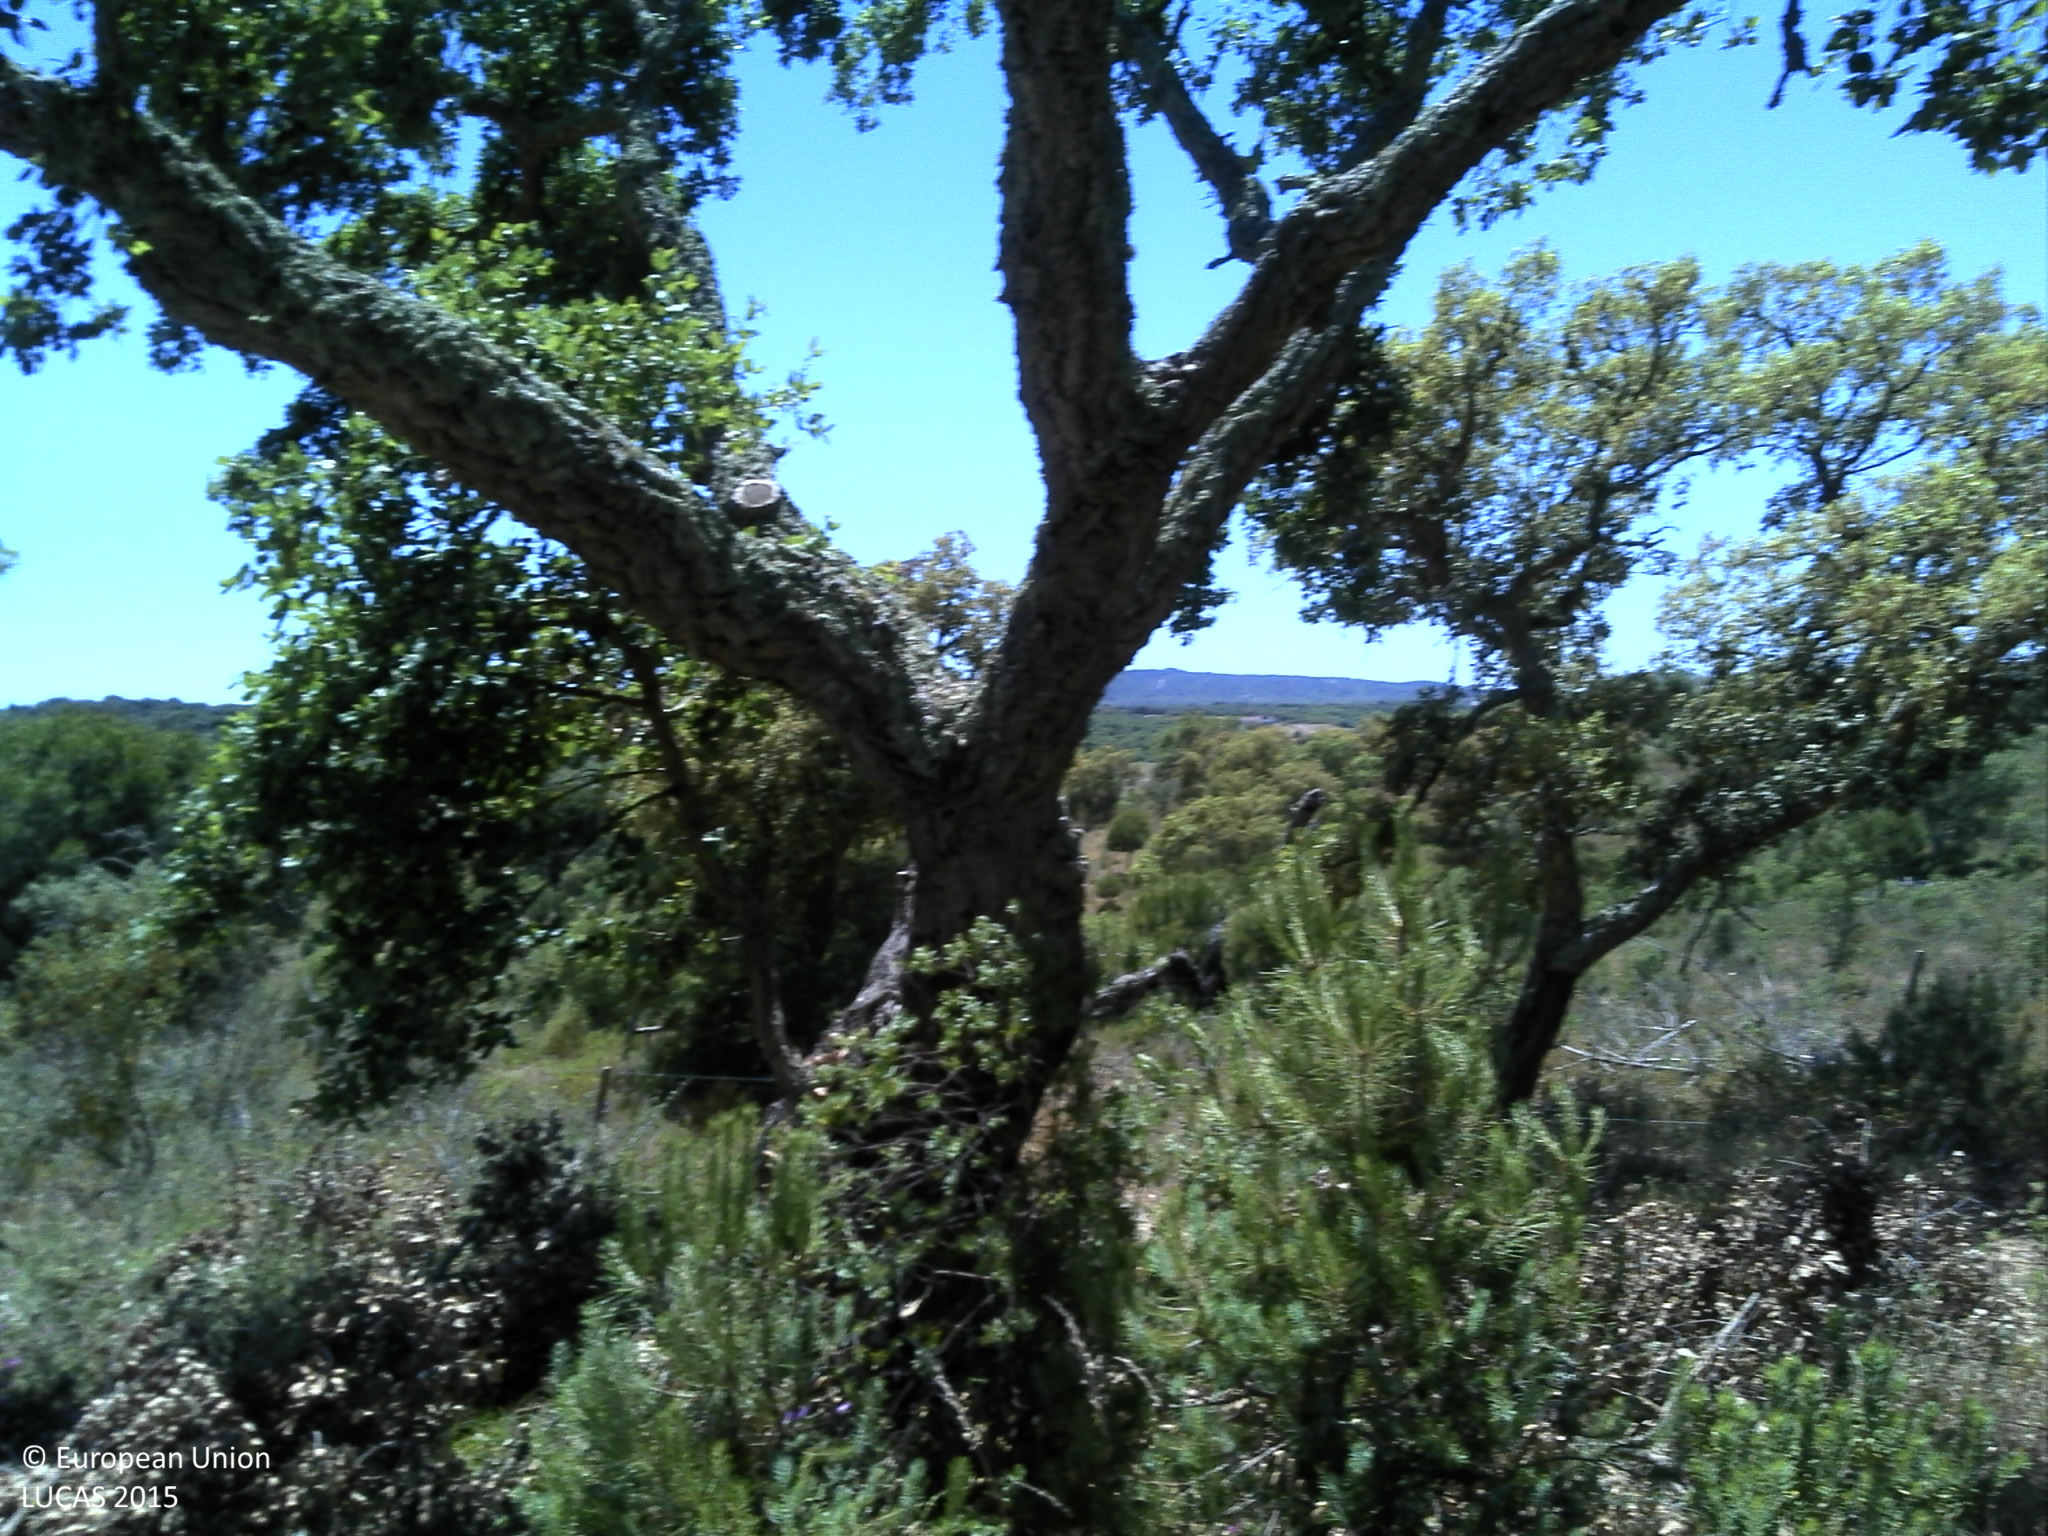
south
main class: Woodland
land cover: Broadleaved woodland
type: broadleaved evergreen forest
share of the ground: 25 - 50 %
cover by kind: herbaceous plants 55 %, broadleaved forest trees 30 %, unconsolidated bare surface 15 %
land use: Forestry
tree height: > 5 m
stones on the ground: < 10 %
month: May
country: PT
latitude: 38.5343
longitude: -8.4651
